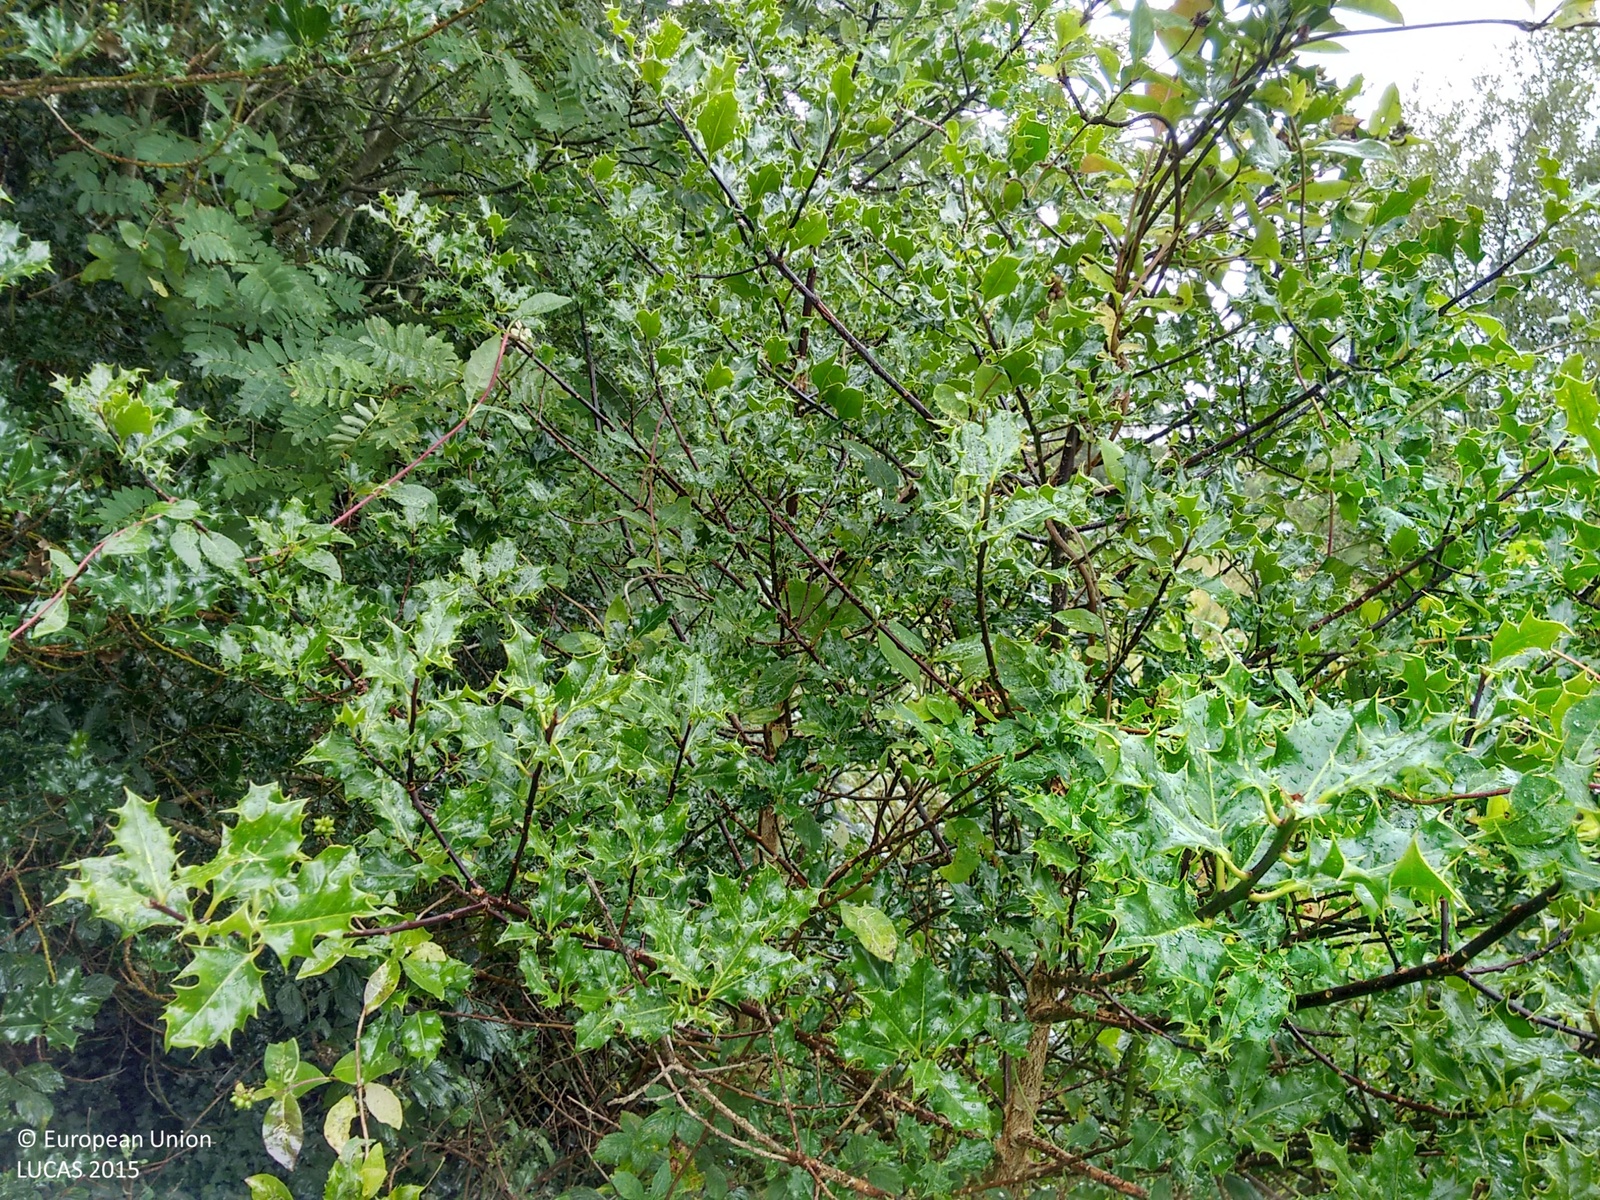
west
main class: Woodland
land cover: Broadleaved woodland
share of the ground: > 75 %
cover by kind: broadleaved forest trees 80 %, herbaceous plants 20 %
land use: Semi-natural and natural areas not in use
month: September
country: IE
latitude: 53.9939
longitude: -9.3058
